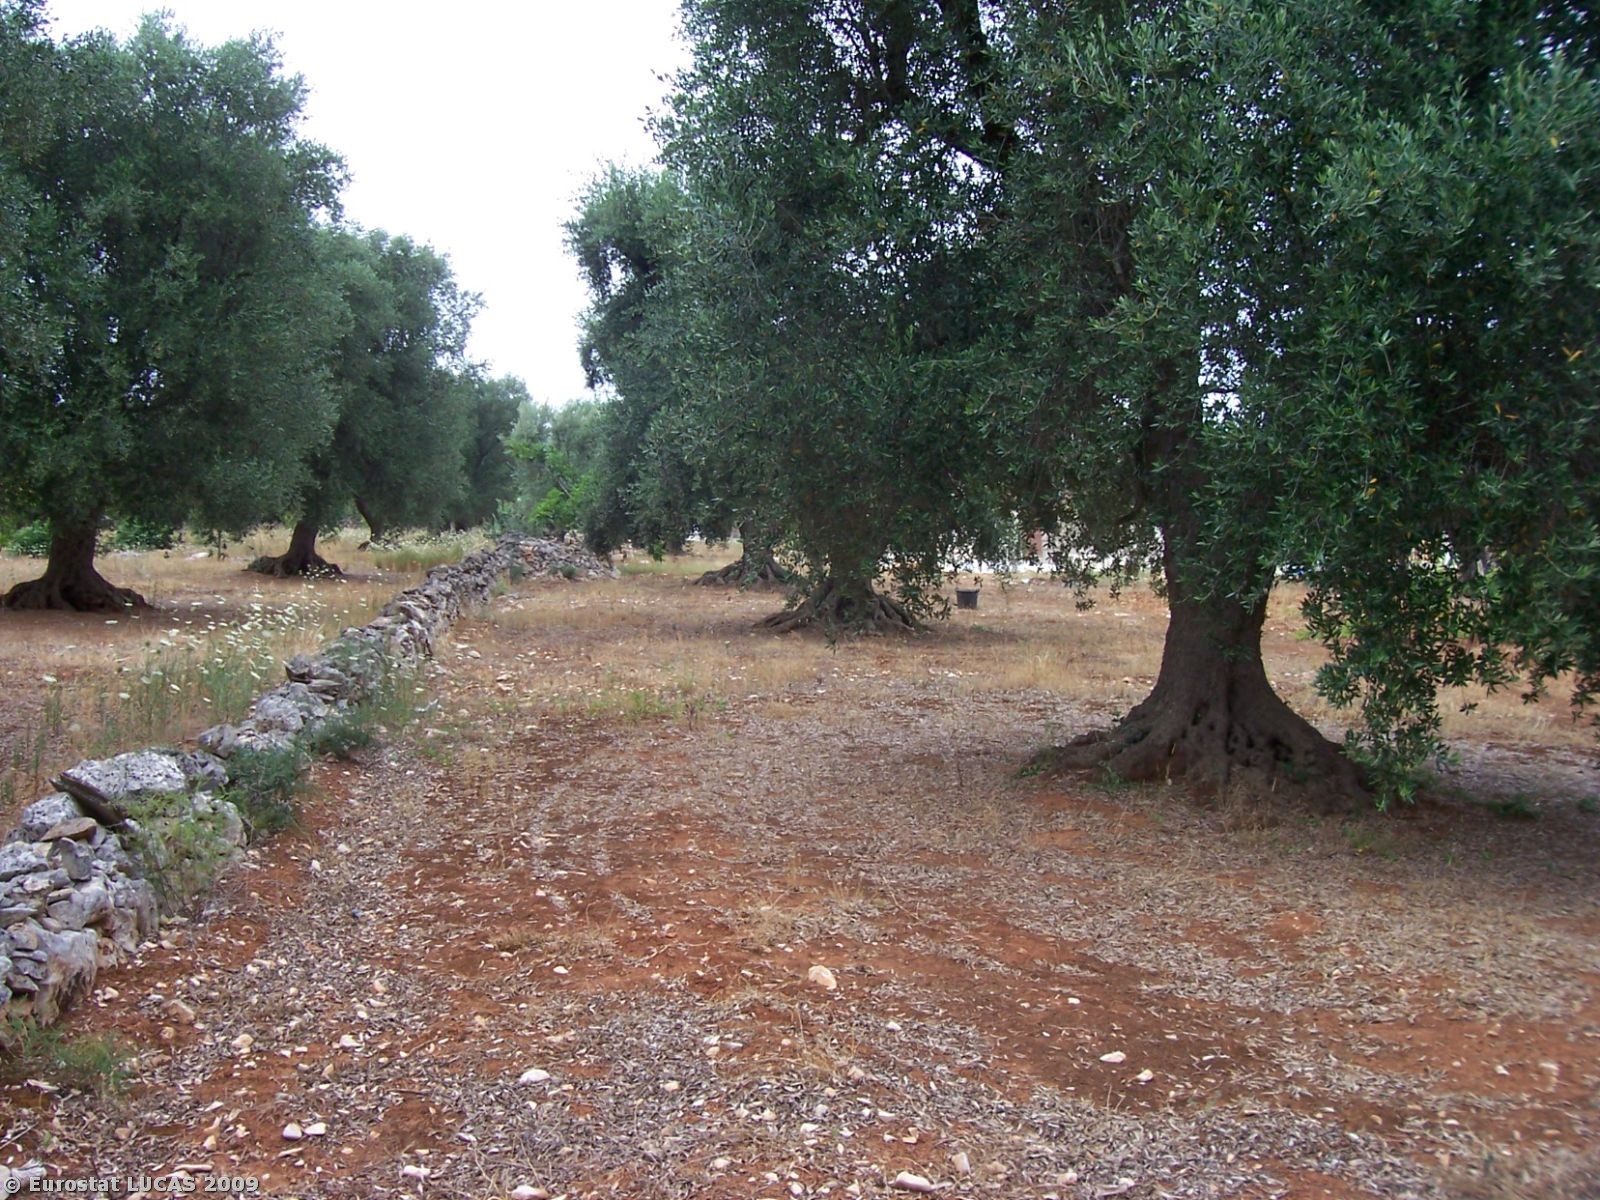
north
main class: Cropland
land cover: Olive groves
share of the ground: 25 - 50 %
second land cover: Bare land
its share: > 75 %
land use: Agriculture (excluding fallow land and kitchen gardens)
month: June
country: IT
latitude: 40.3957
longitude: 17.5271
